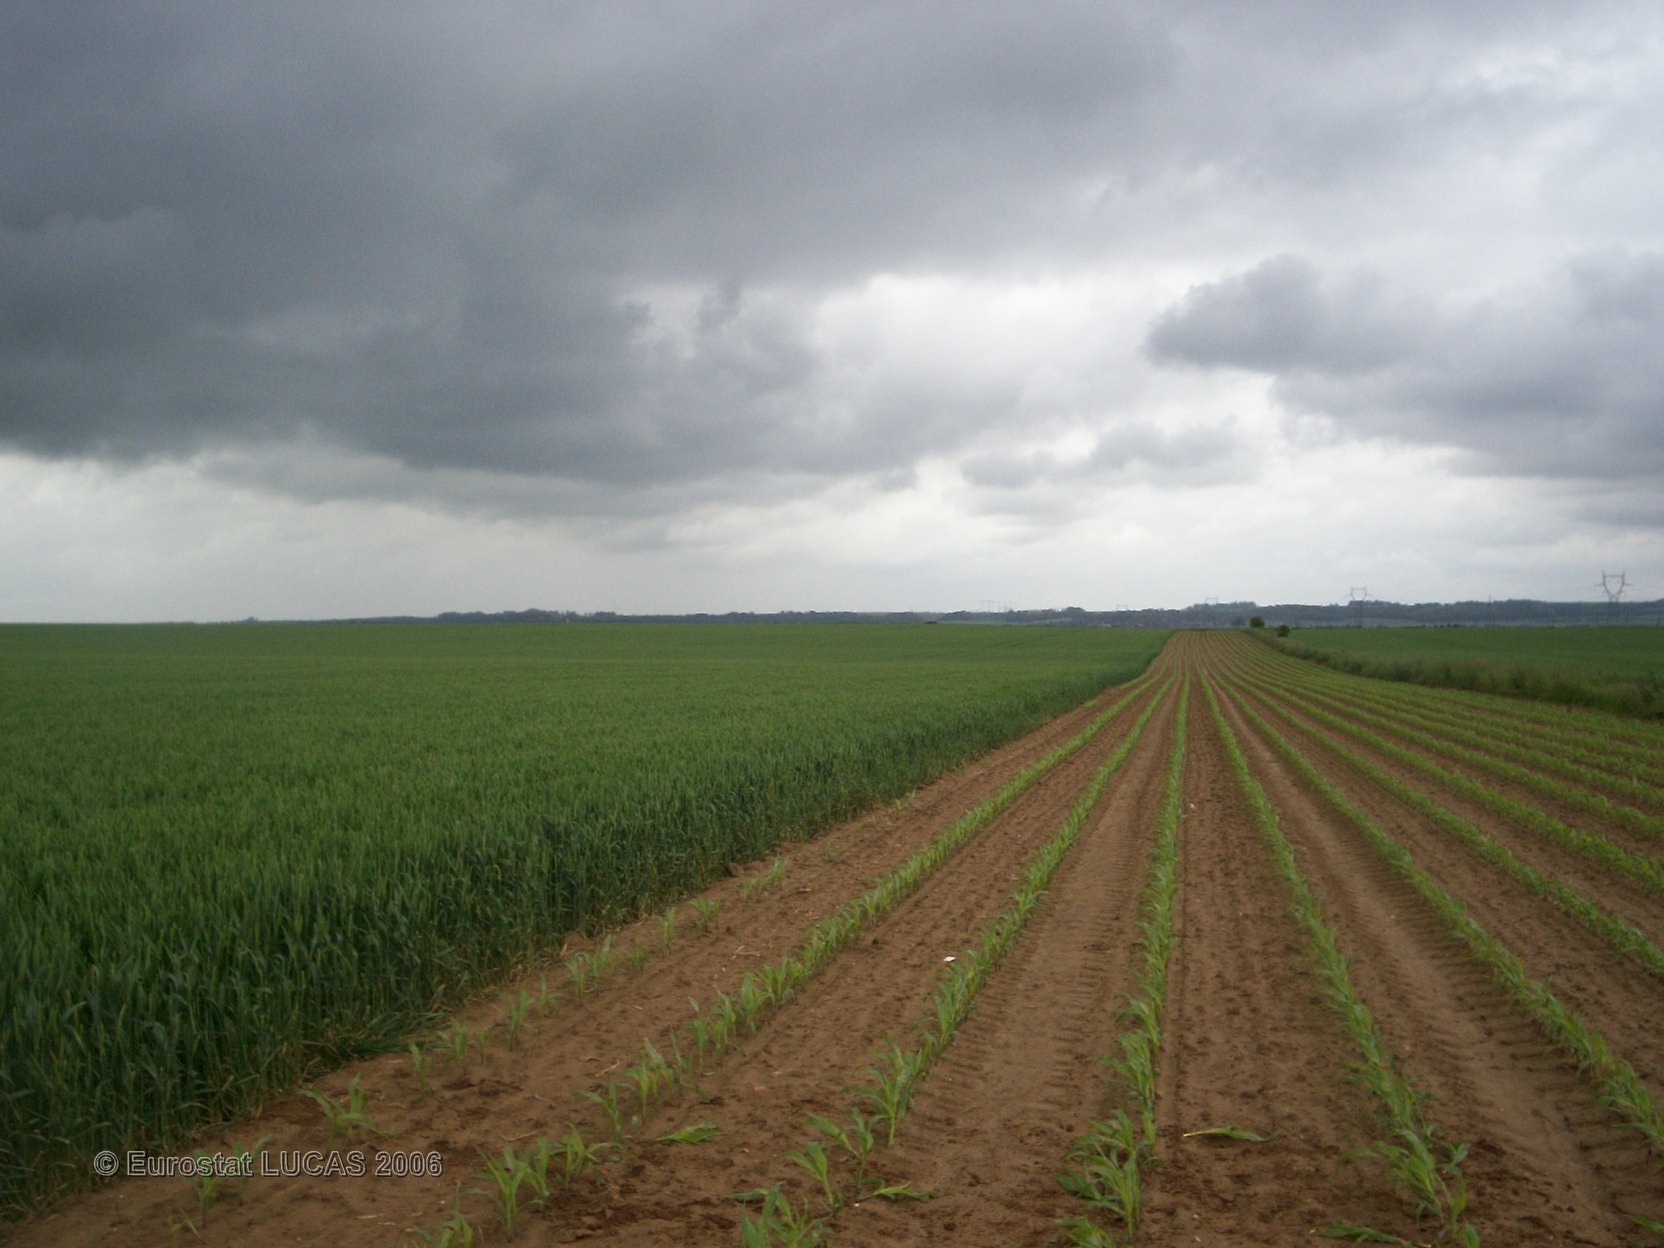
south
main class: Cropland
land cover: Maize
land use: Agriculture (excluding fallow land and kitchen gardens)
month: May
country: FR
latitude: 49.2491
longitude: 2.7498
